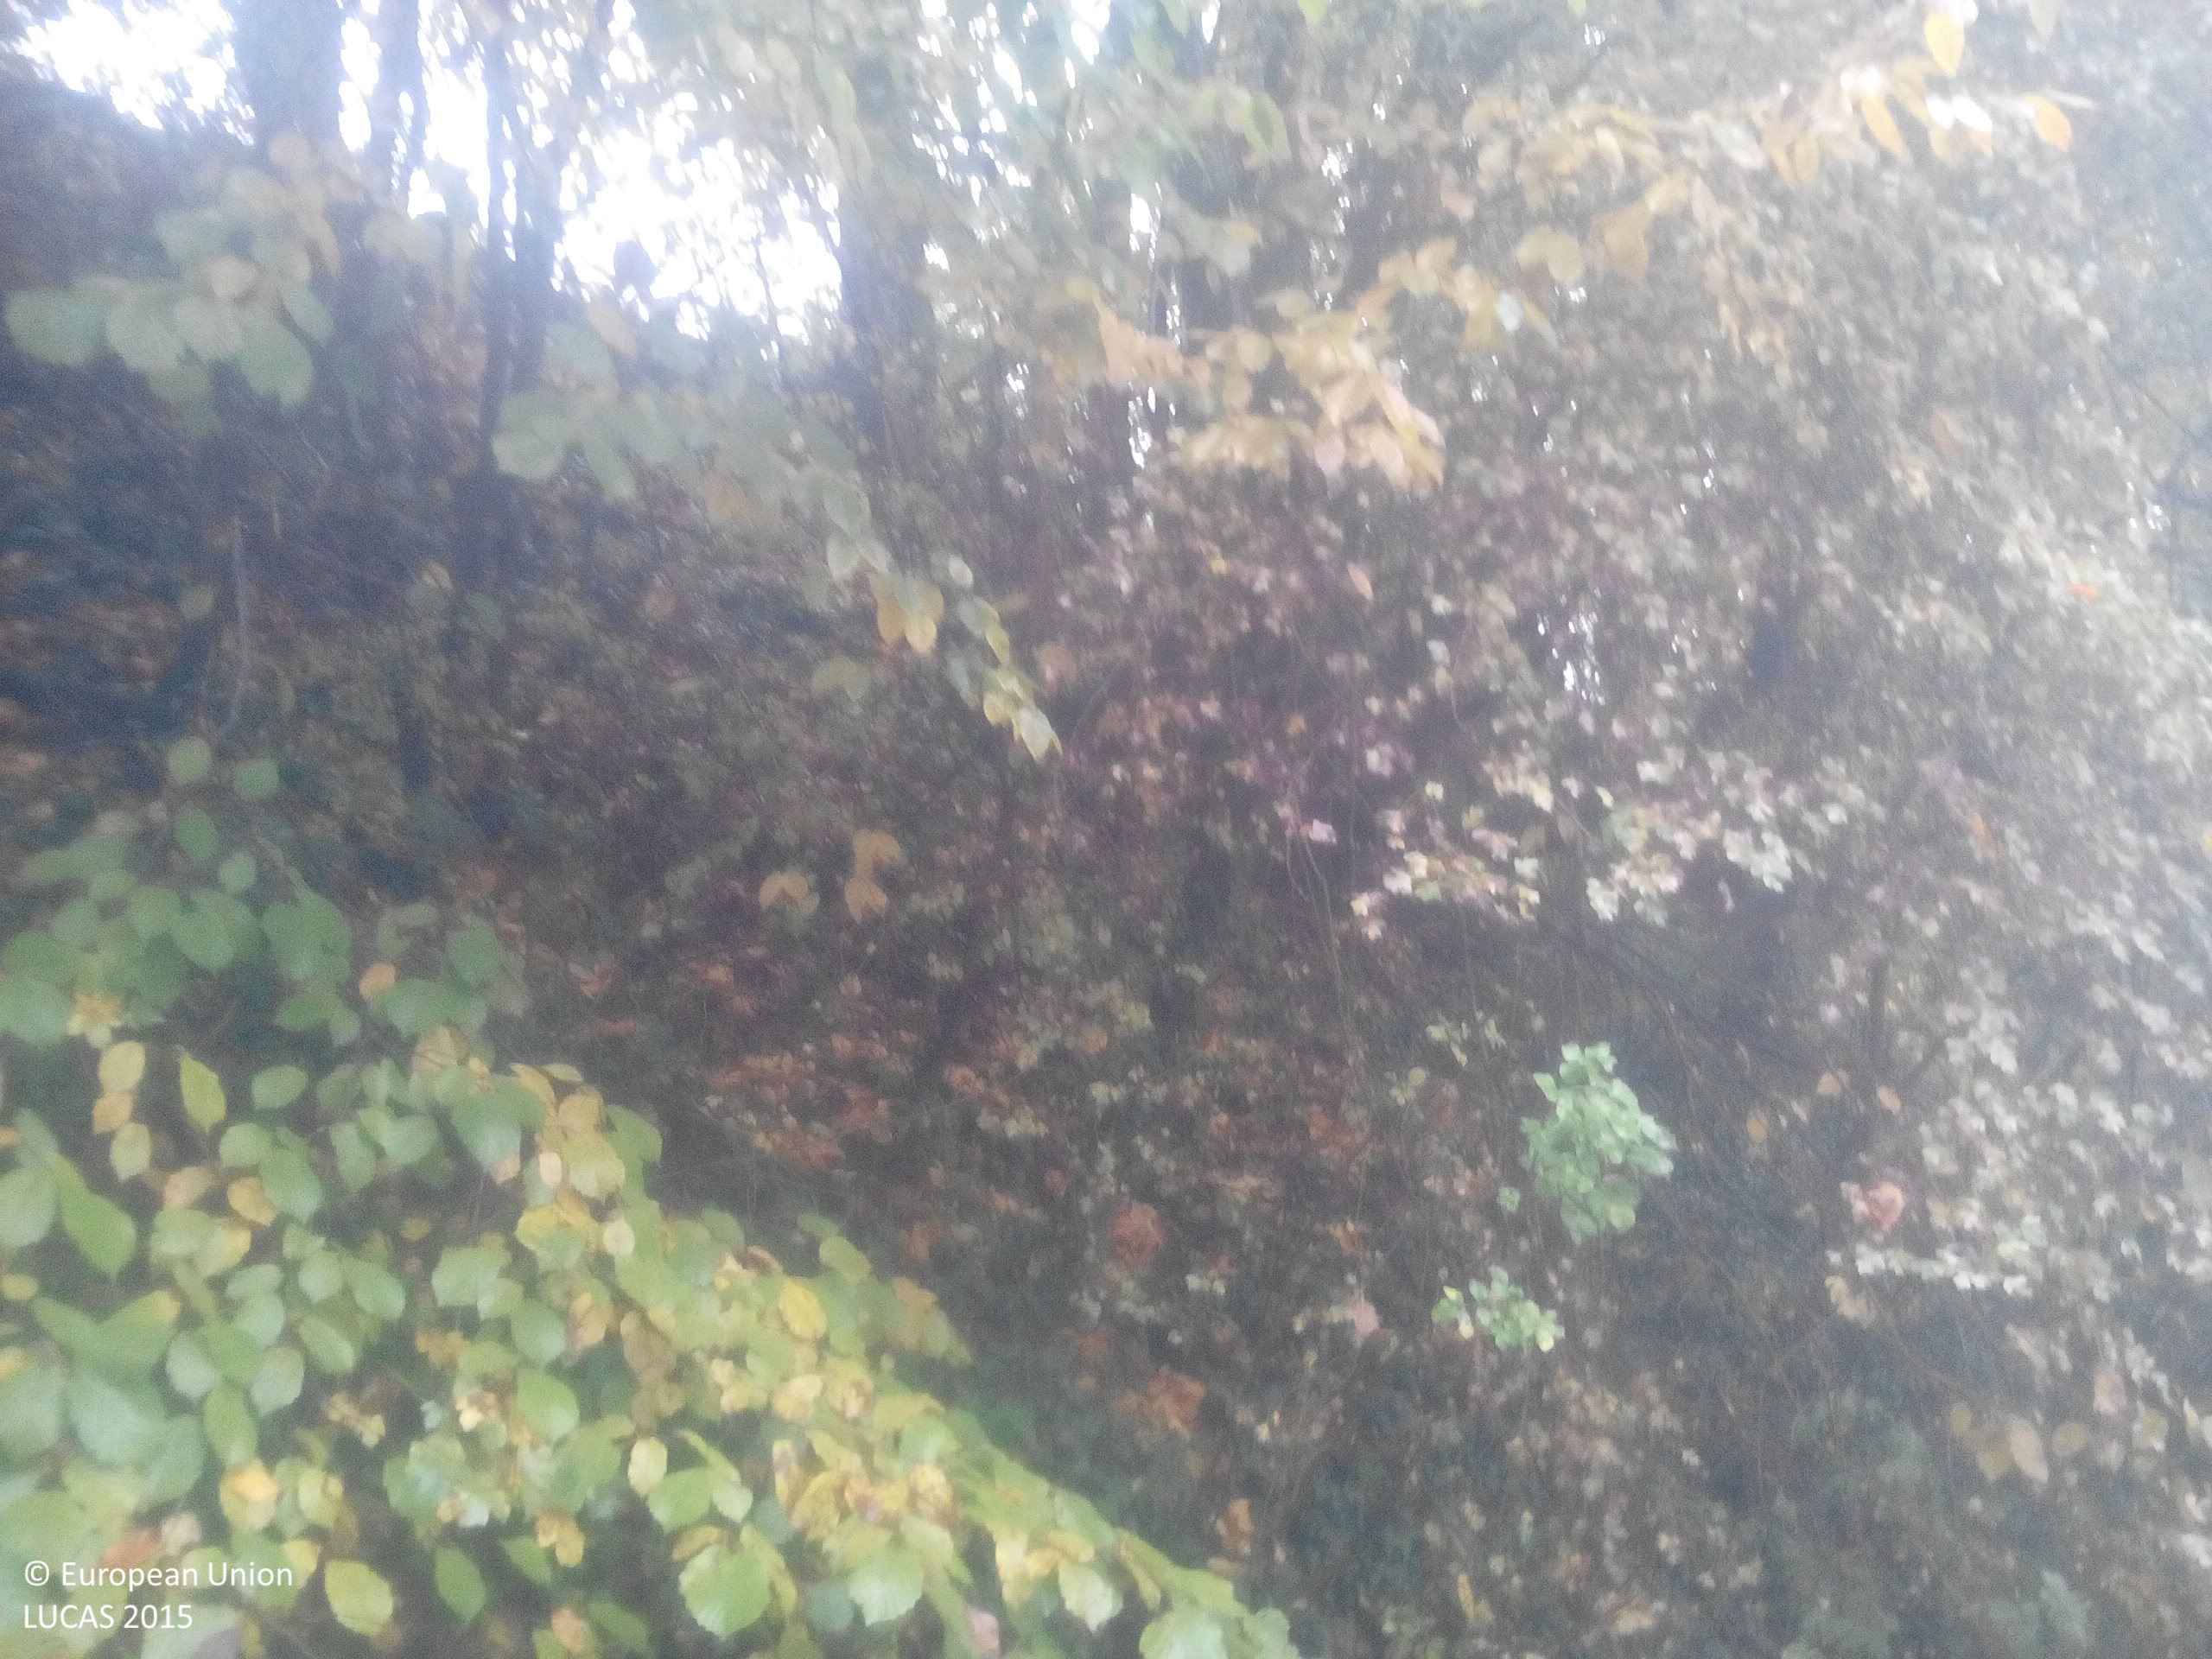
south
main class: Woodland
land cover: Broadleaved woodland
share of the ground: 50 - 75 %
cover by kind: broadleaved forest trees 70 %, herbaceous plants 20 %, shrubs 10 %
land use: Semi-natural and natural areas not in use
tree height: > 5 m
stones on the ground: < 10 %
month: October
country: BG
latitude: 42.9962
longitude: 24.2436
